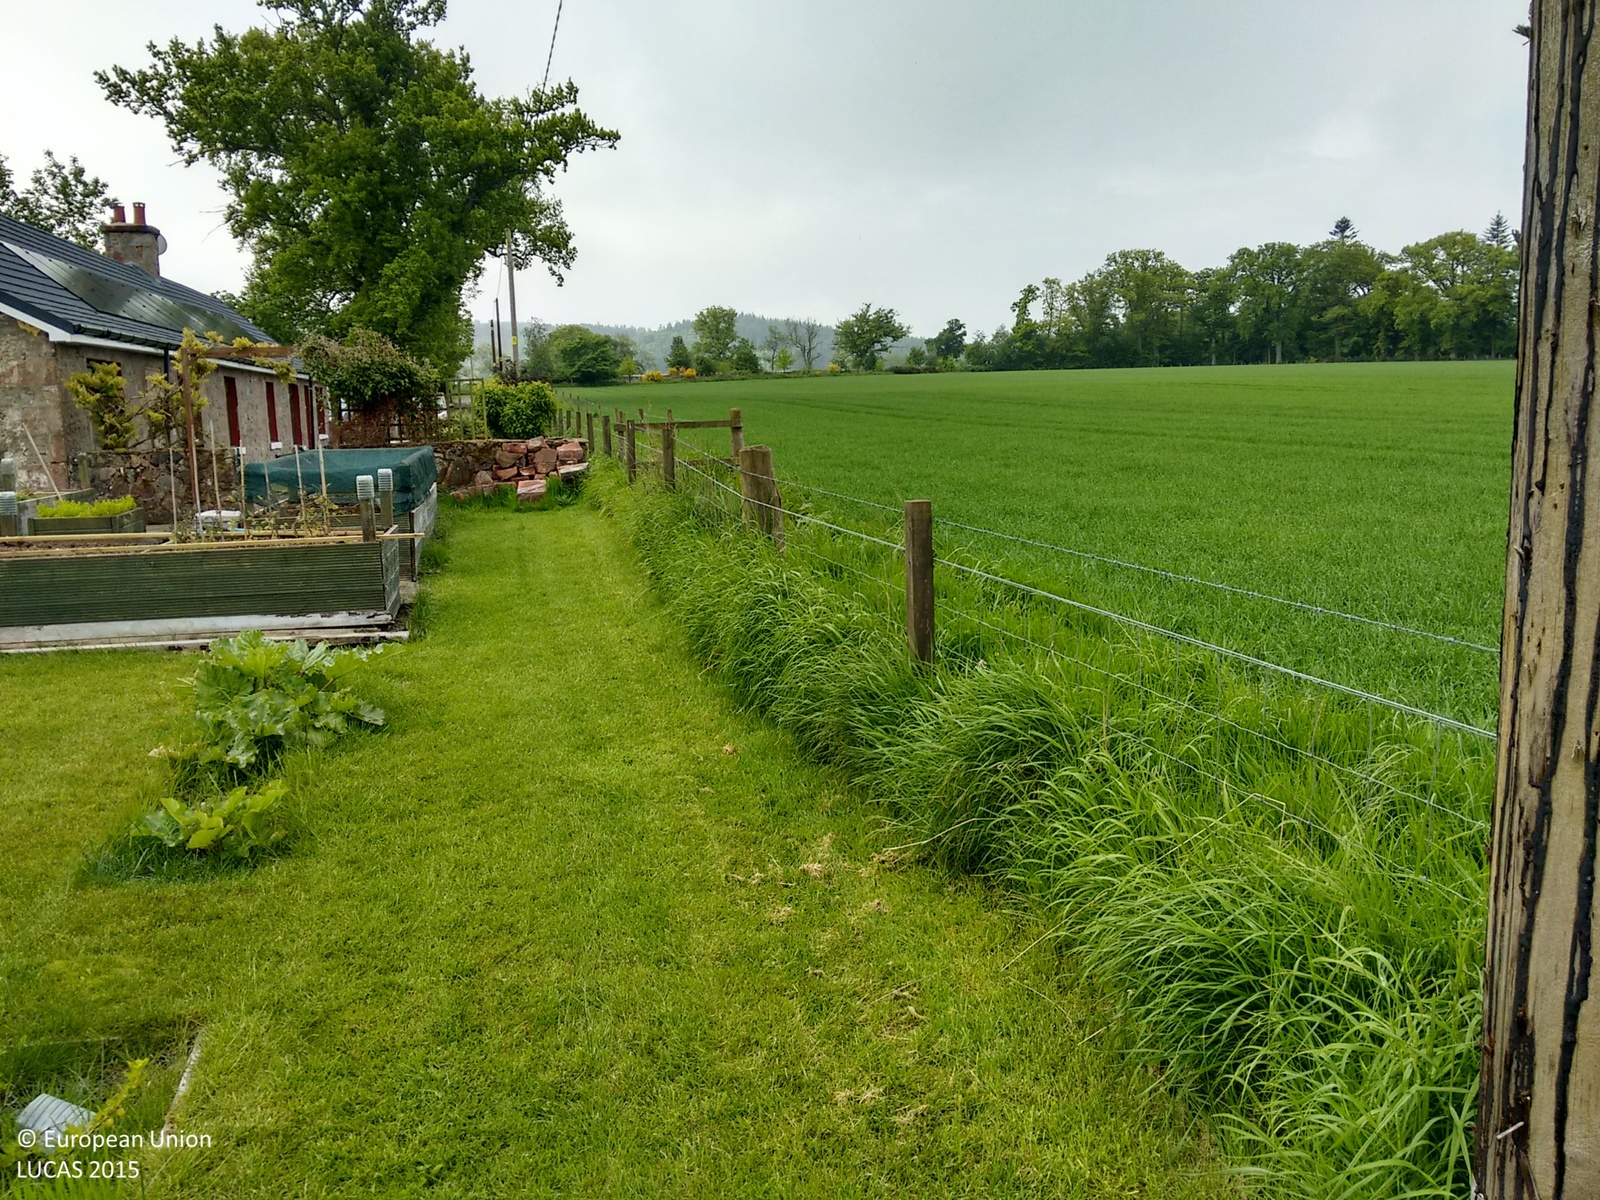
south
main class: Grassland
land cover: Grassland without tree/shrub cover
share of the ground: > 75 %
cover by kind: herbaceous plants 100 %
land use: Residential
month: June
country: GB
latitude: 56.3476
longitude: -3.4891
